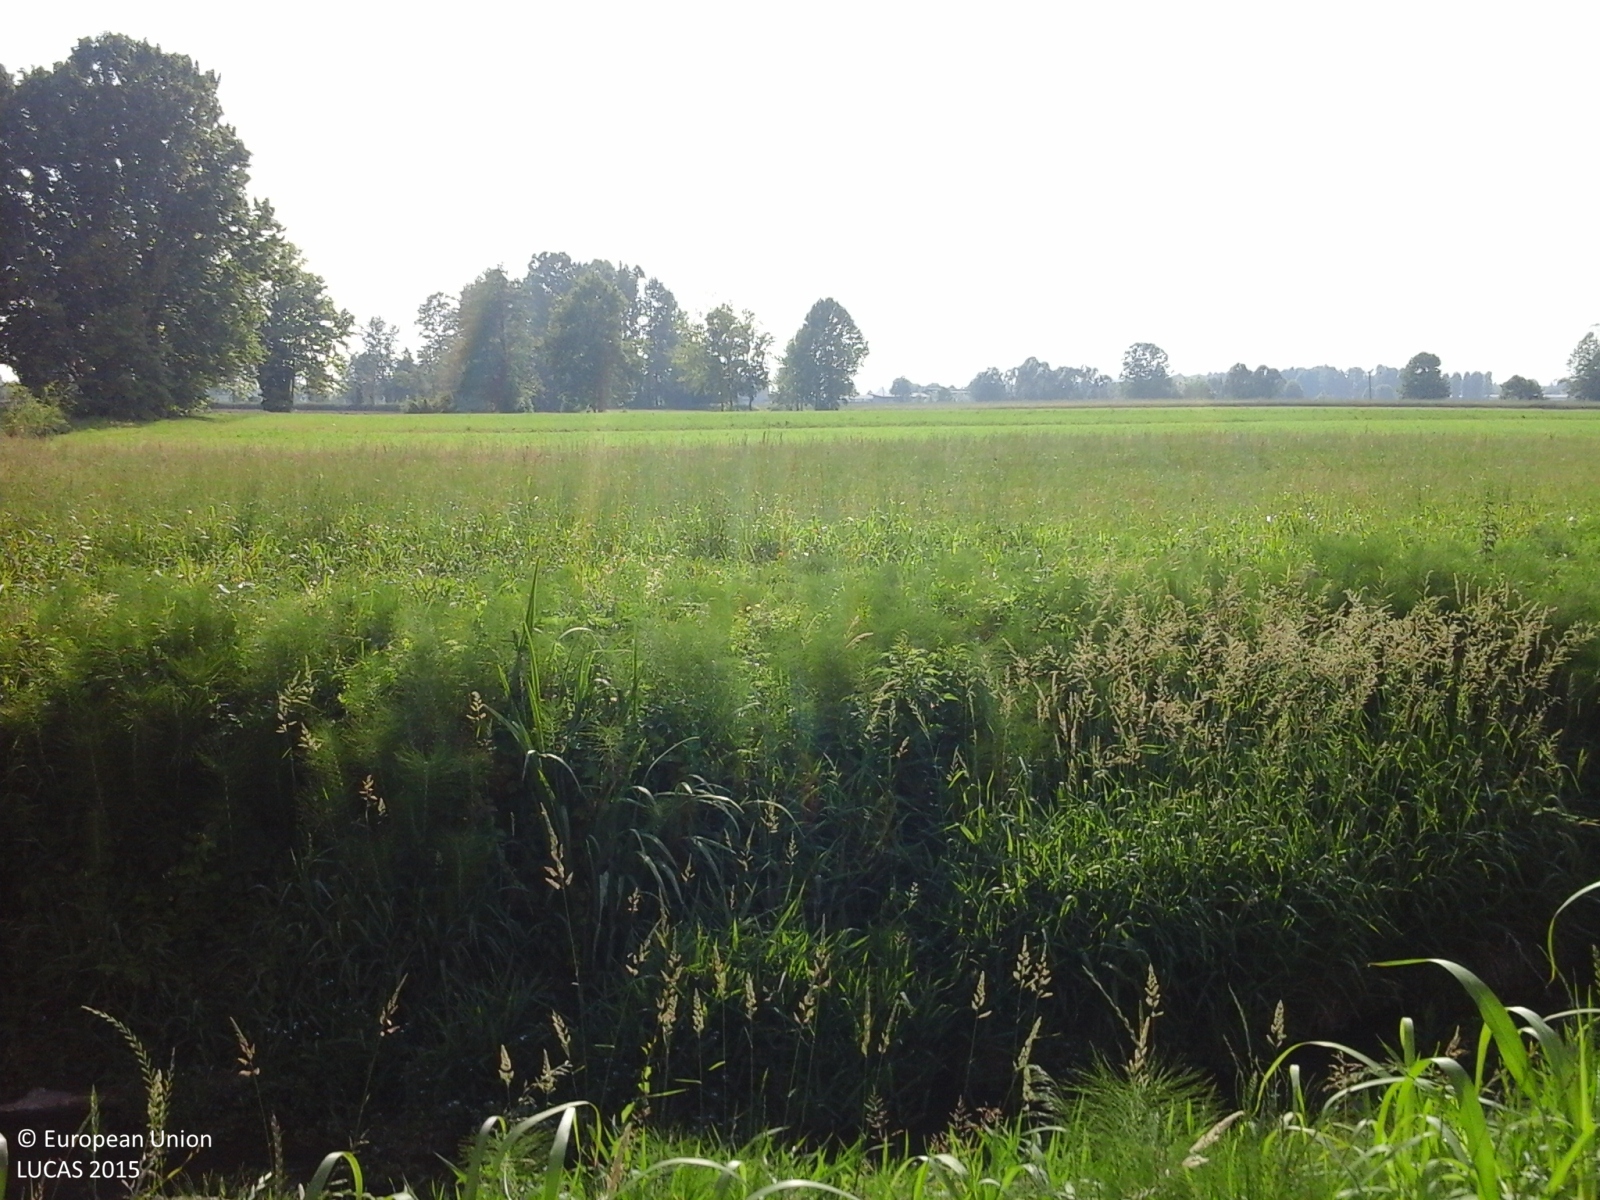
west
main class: Cropland
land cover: Lucerne
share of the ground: > 75 %
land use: Agriculture (excluding fallow land and kitchen gardens)
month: May
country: IT
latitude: 45.5039
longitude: 9.6806
